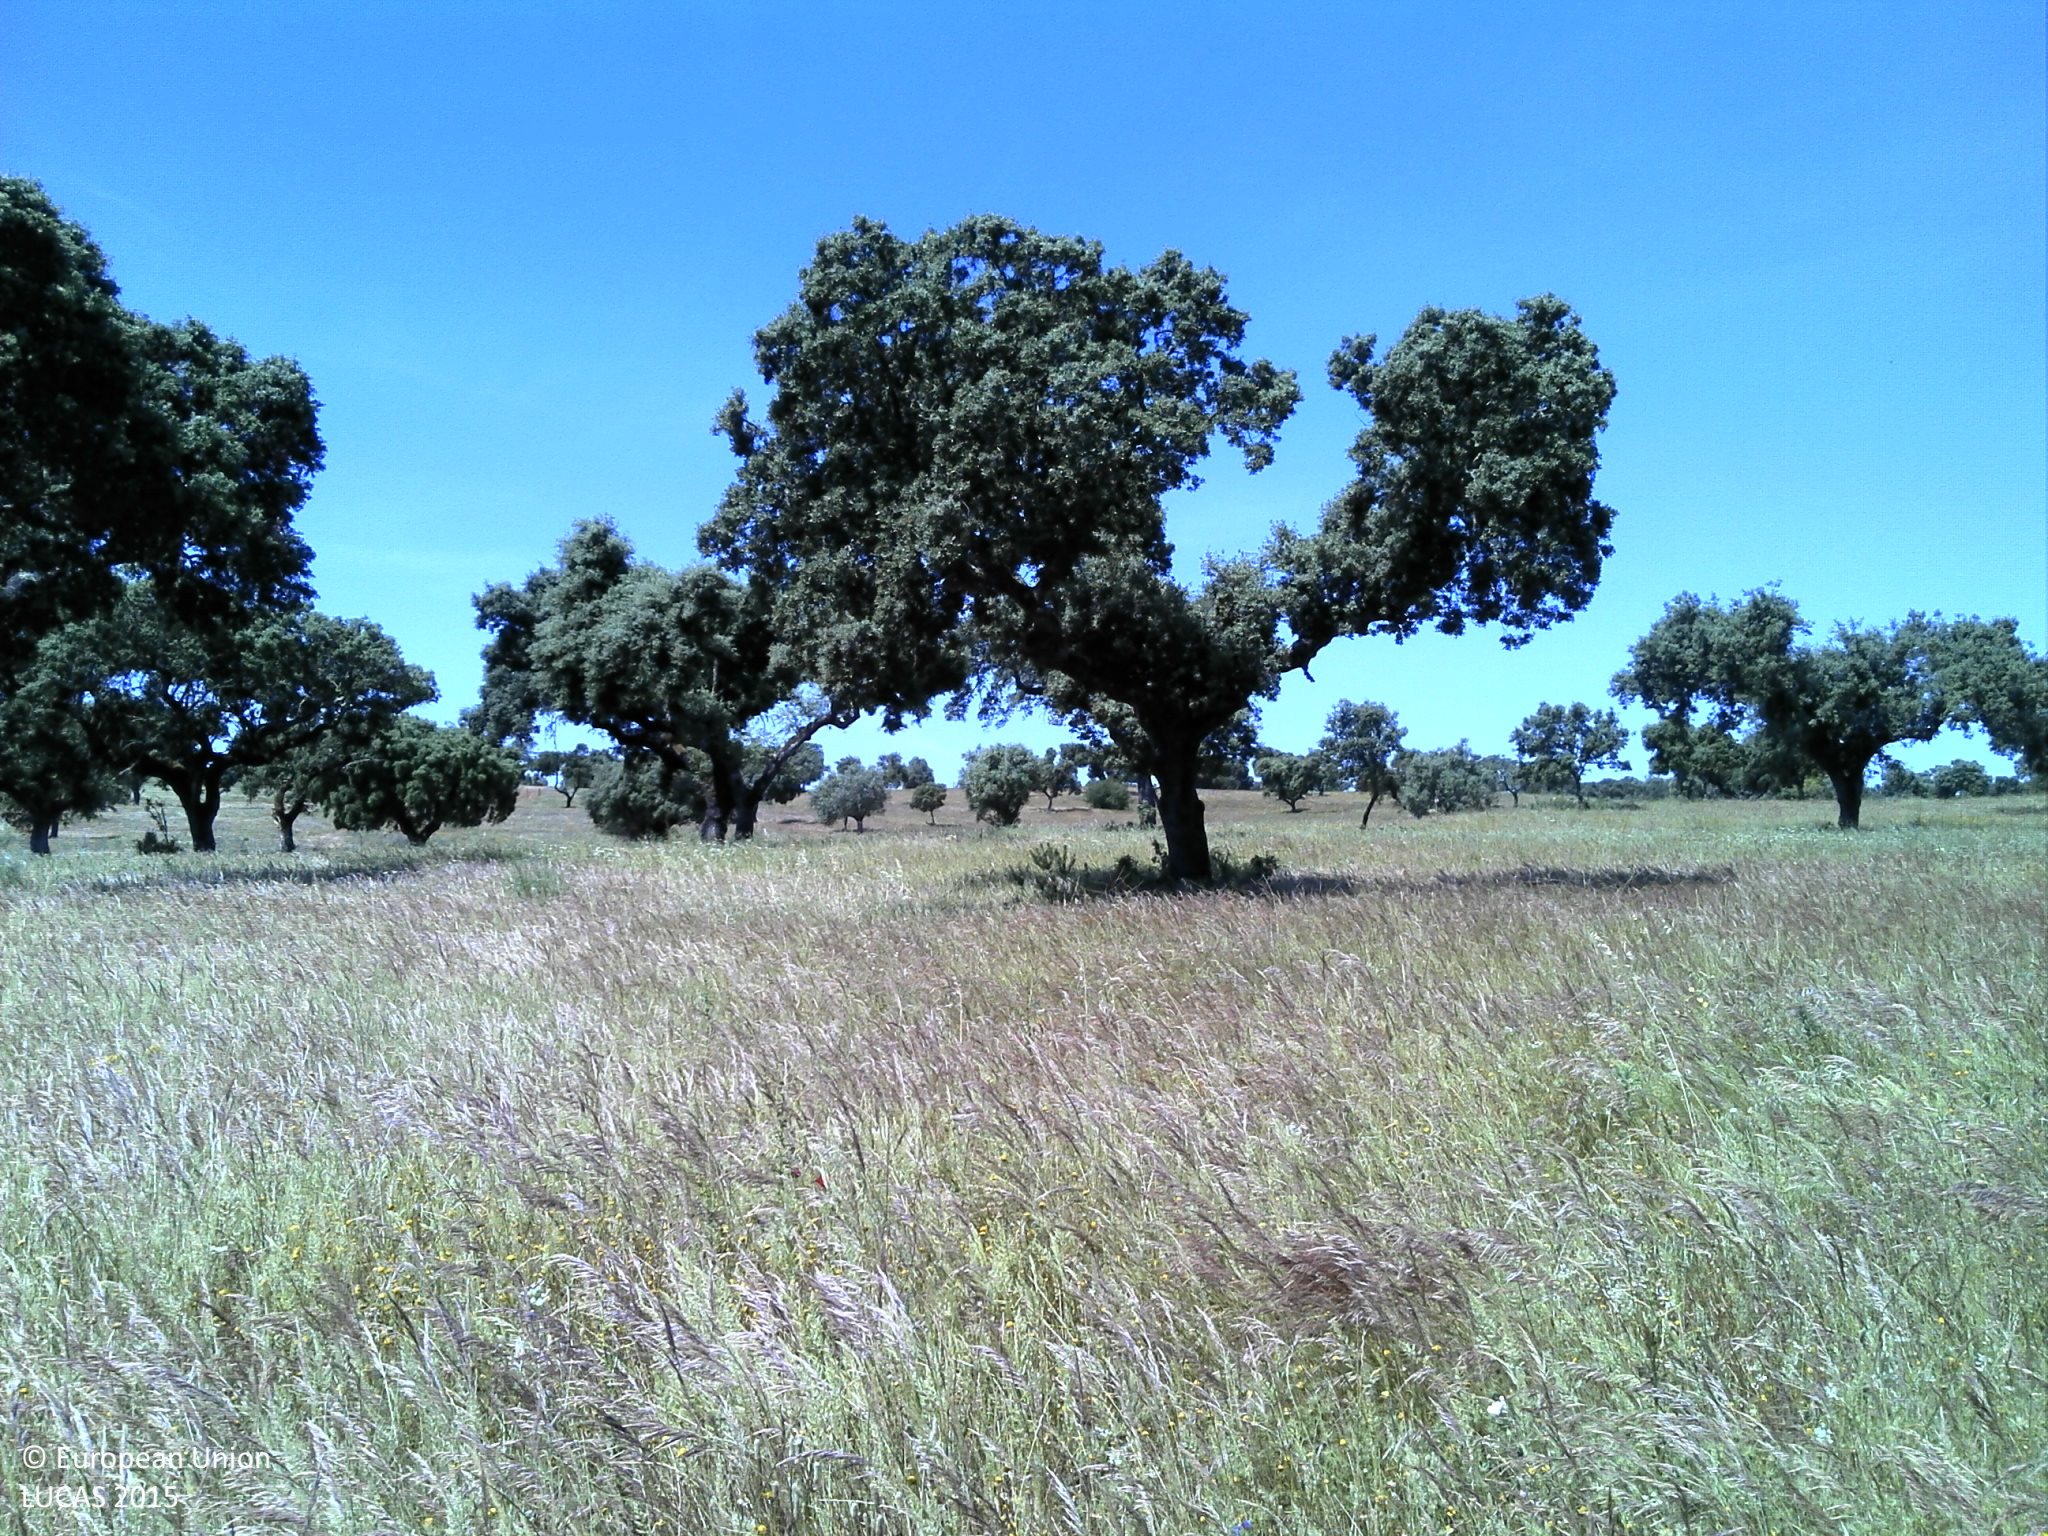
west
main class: Grassland
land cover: Grassland with sparse tree/shrub cover
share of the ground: > 75 %
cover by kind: herbaceous plants 90 %, broadleaved forest trees 5 %, unconsolidated bare surface 5 %
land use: Agriculture (excluding fallow land and kitchen gardens)
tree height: > 5 m
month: May
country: PT
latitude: 39.1499
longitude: -7.8571
